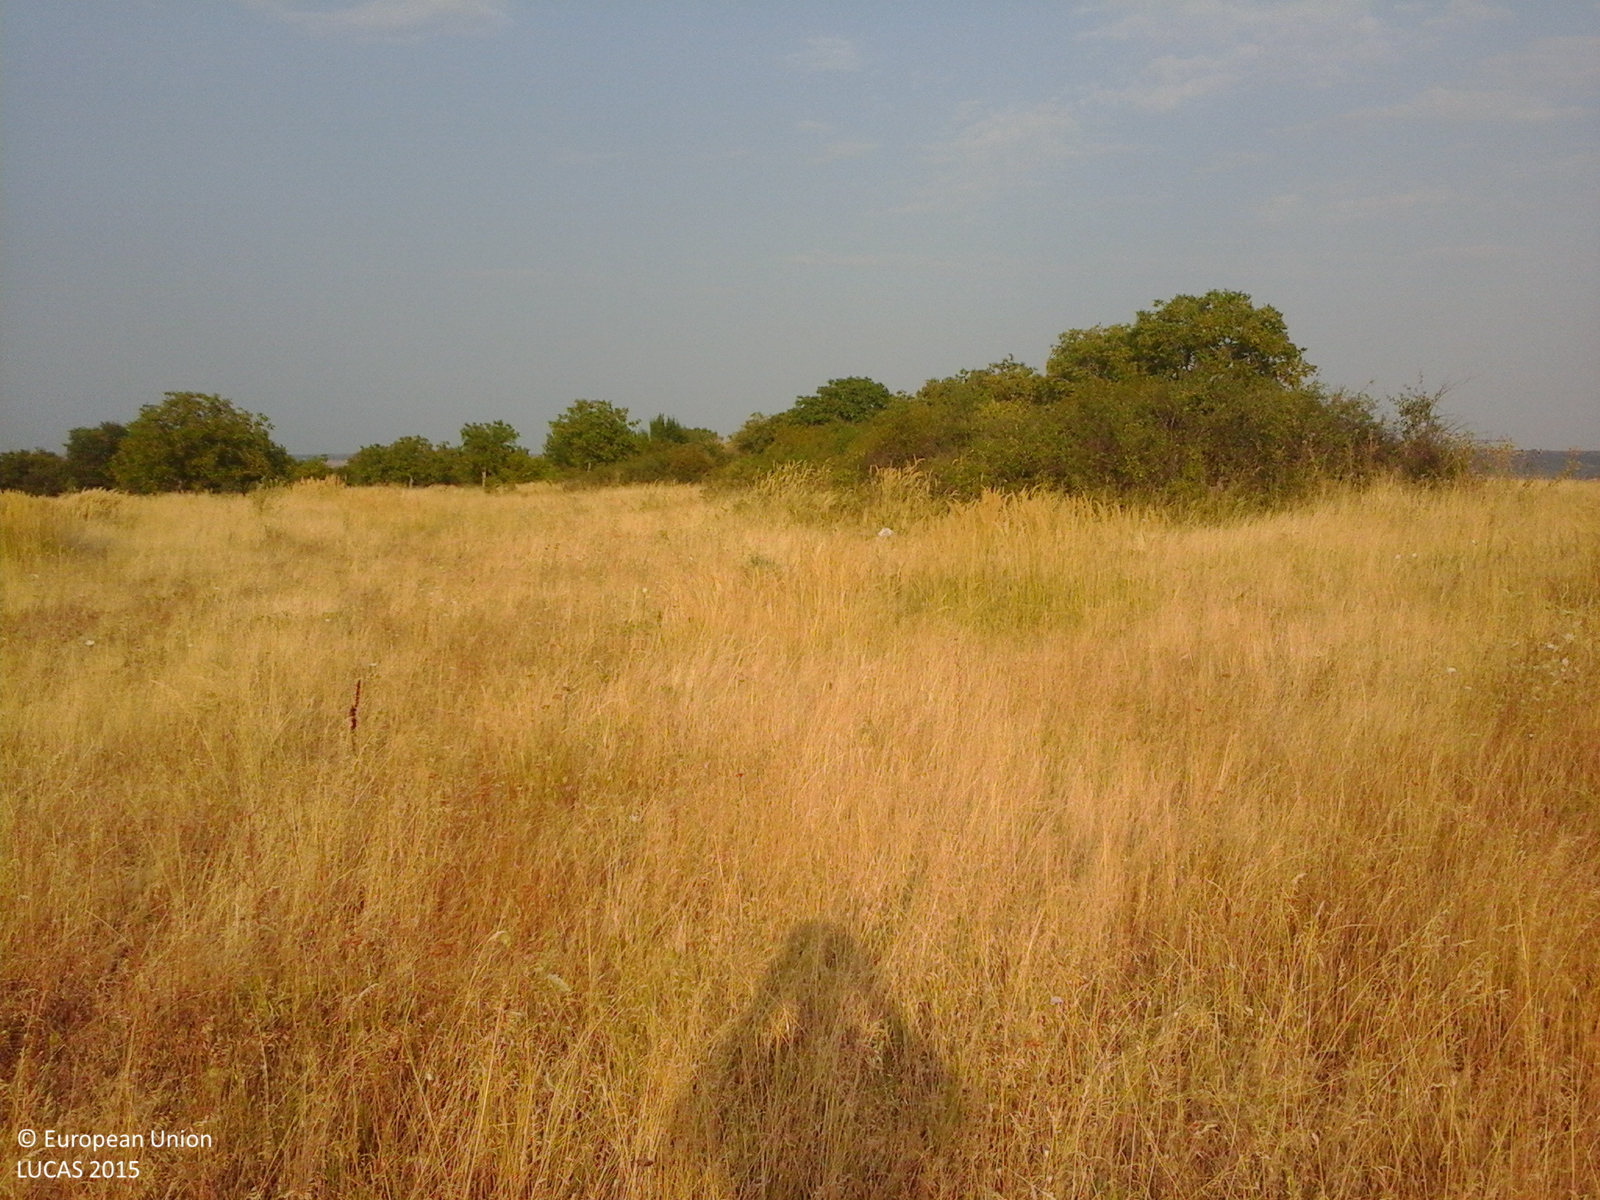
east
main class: Grassland
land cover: Grassland without tree/shrub cover
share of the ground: > 75 %
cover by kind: herbaceous plants 100 %
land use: Agriculture (excluding fallow land and kitchen gardens)
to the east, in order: Grassland without tree/shrub cover; Shrubland without tree cover; Grass margins; Paved roads, cycling and walking lanes; Grass margins; Abandoned hedges; Grassland without tree/shrub cover; Lucerne; Tracks; Single bushes/trees; Spontaneously vegetated surfaces
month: August
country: RO
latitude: 44.4414
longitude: 22.9989
